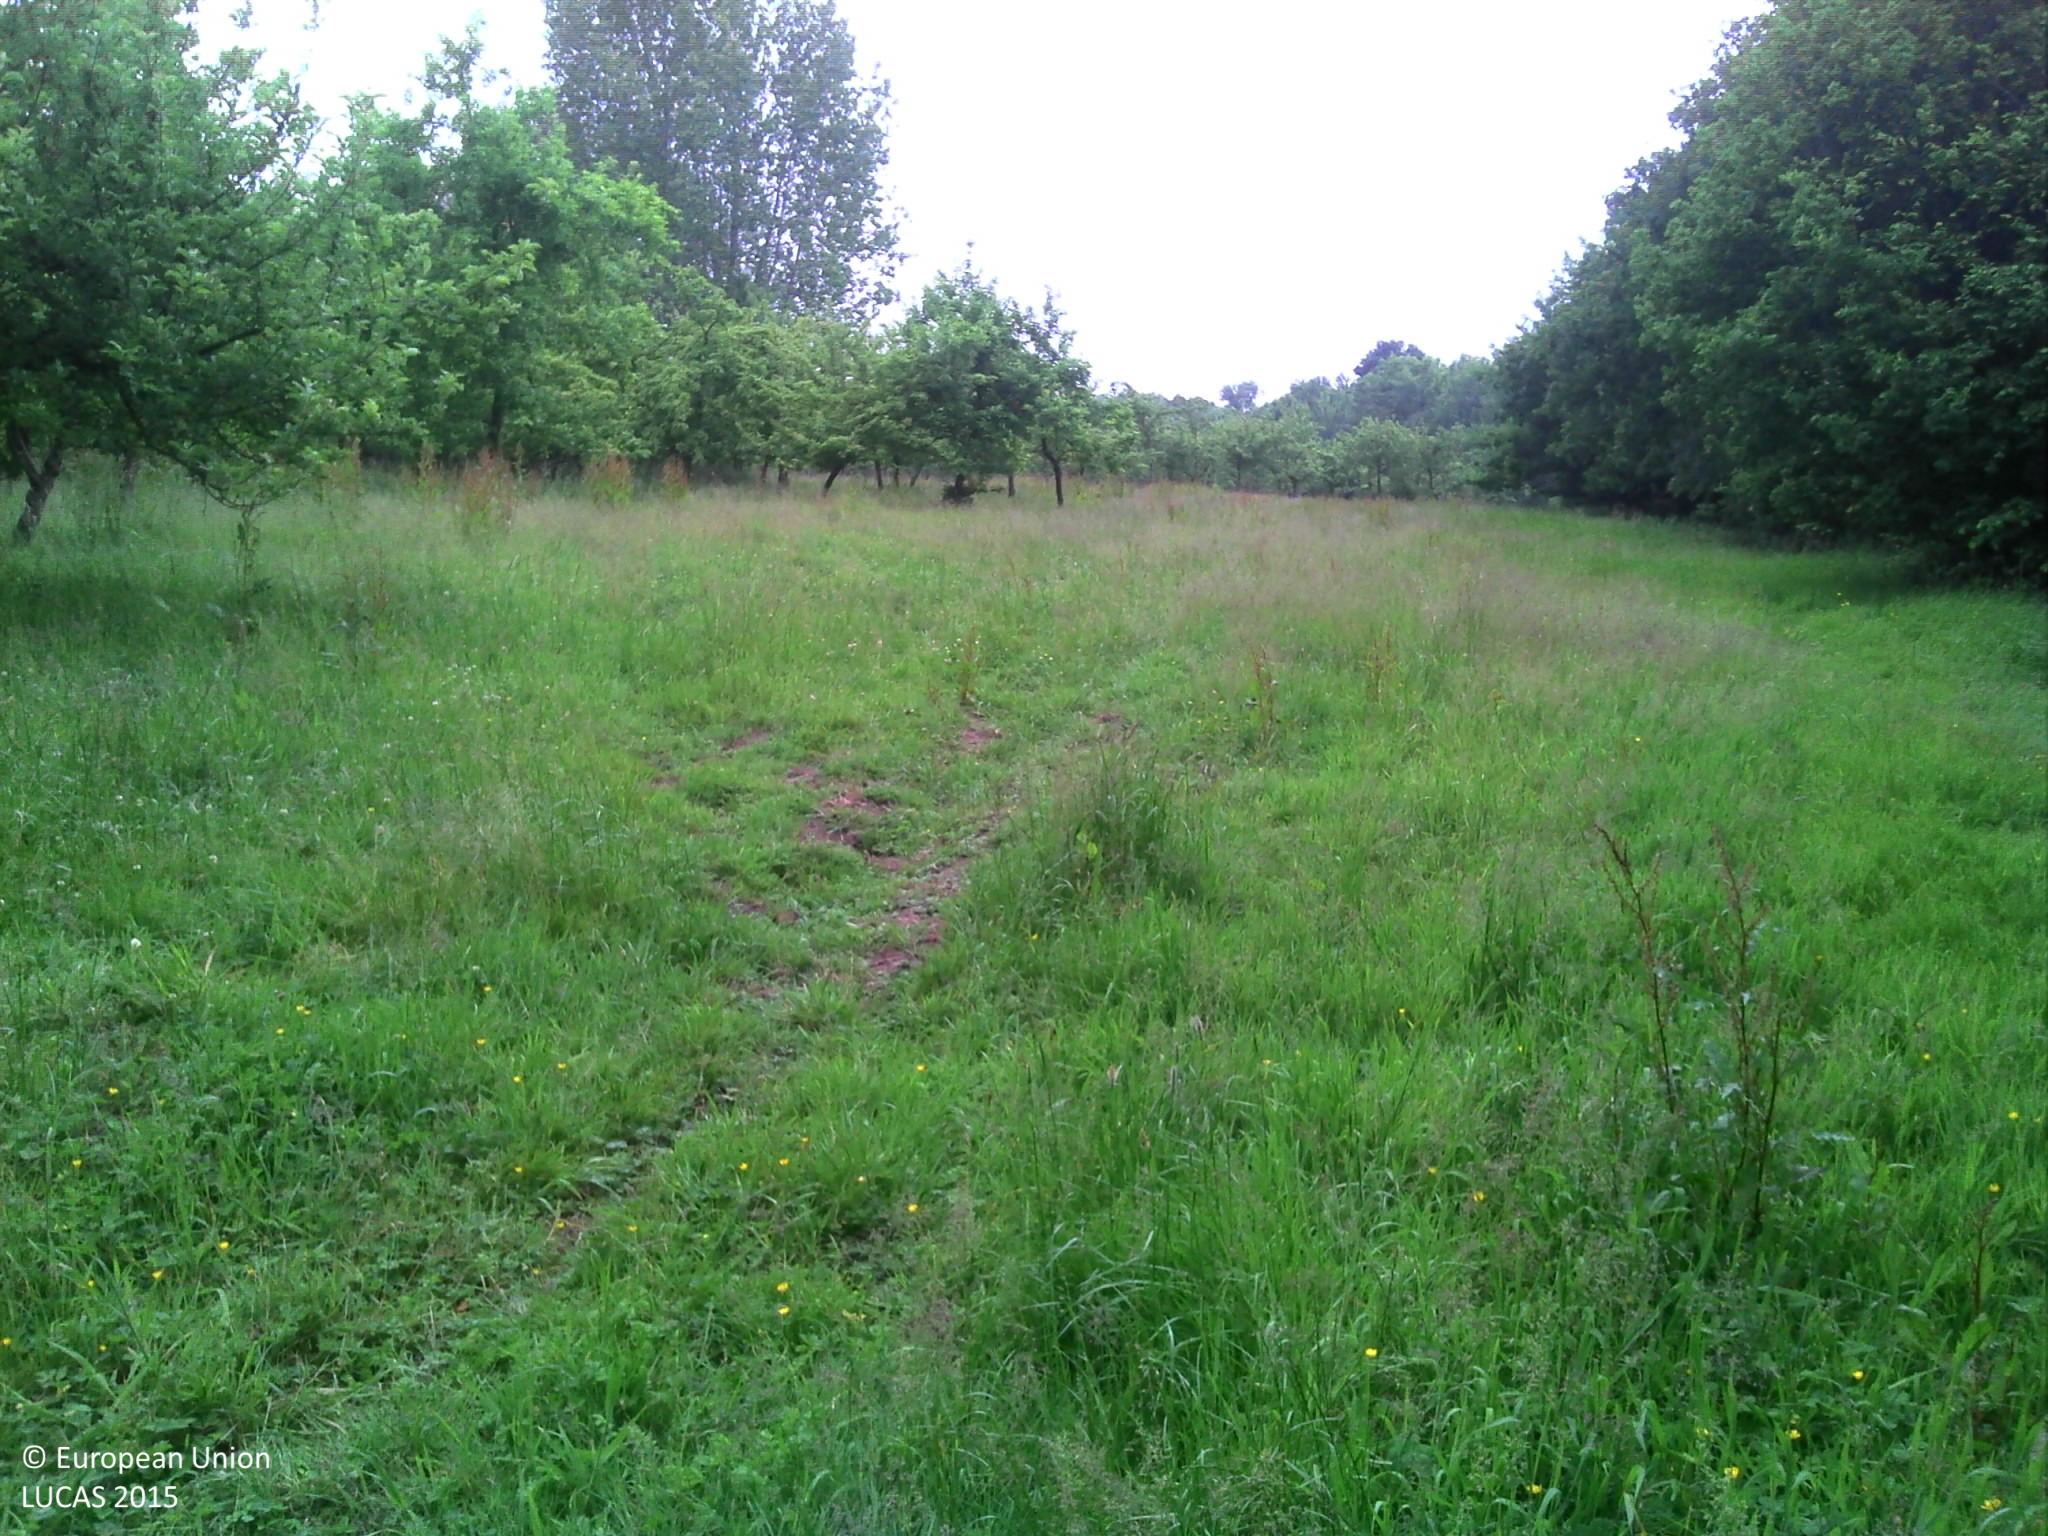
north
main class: Grassland
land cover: Grassland without tree/shrub cover
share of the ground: > 75 %
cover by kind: herbaceous plants 100 %
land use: Agriculture (excluding fallow land and kitchen gardens)
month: June
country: FR
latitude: 49.2500
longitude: -0.0466
